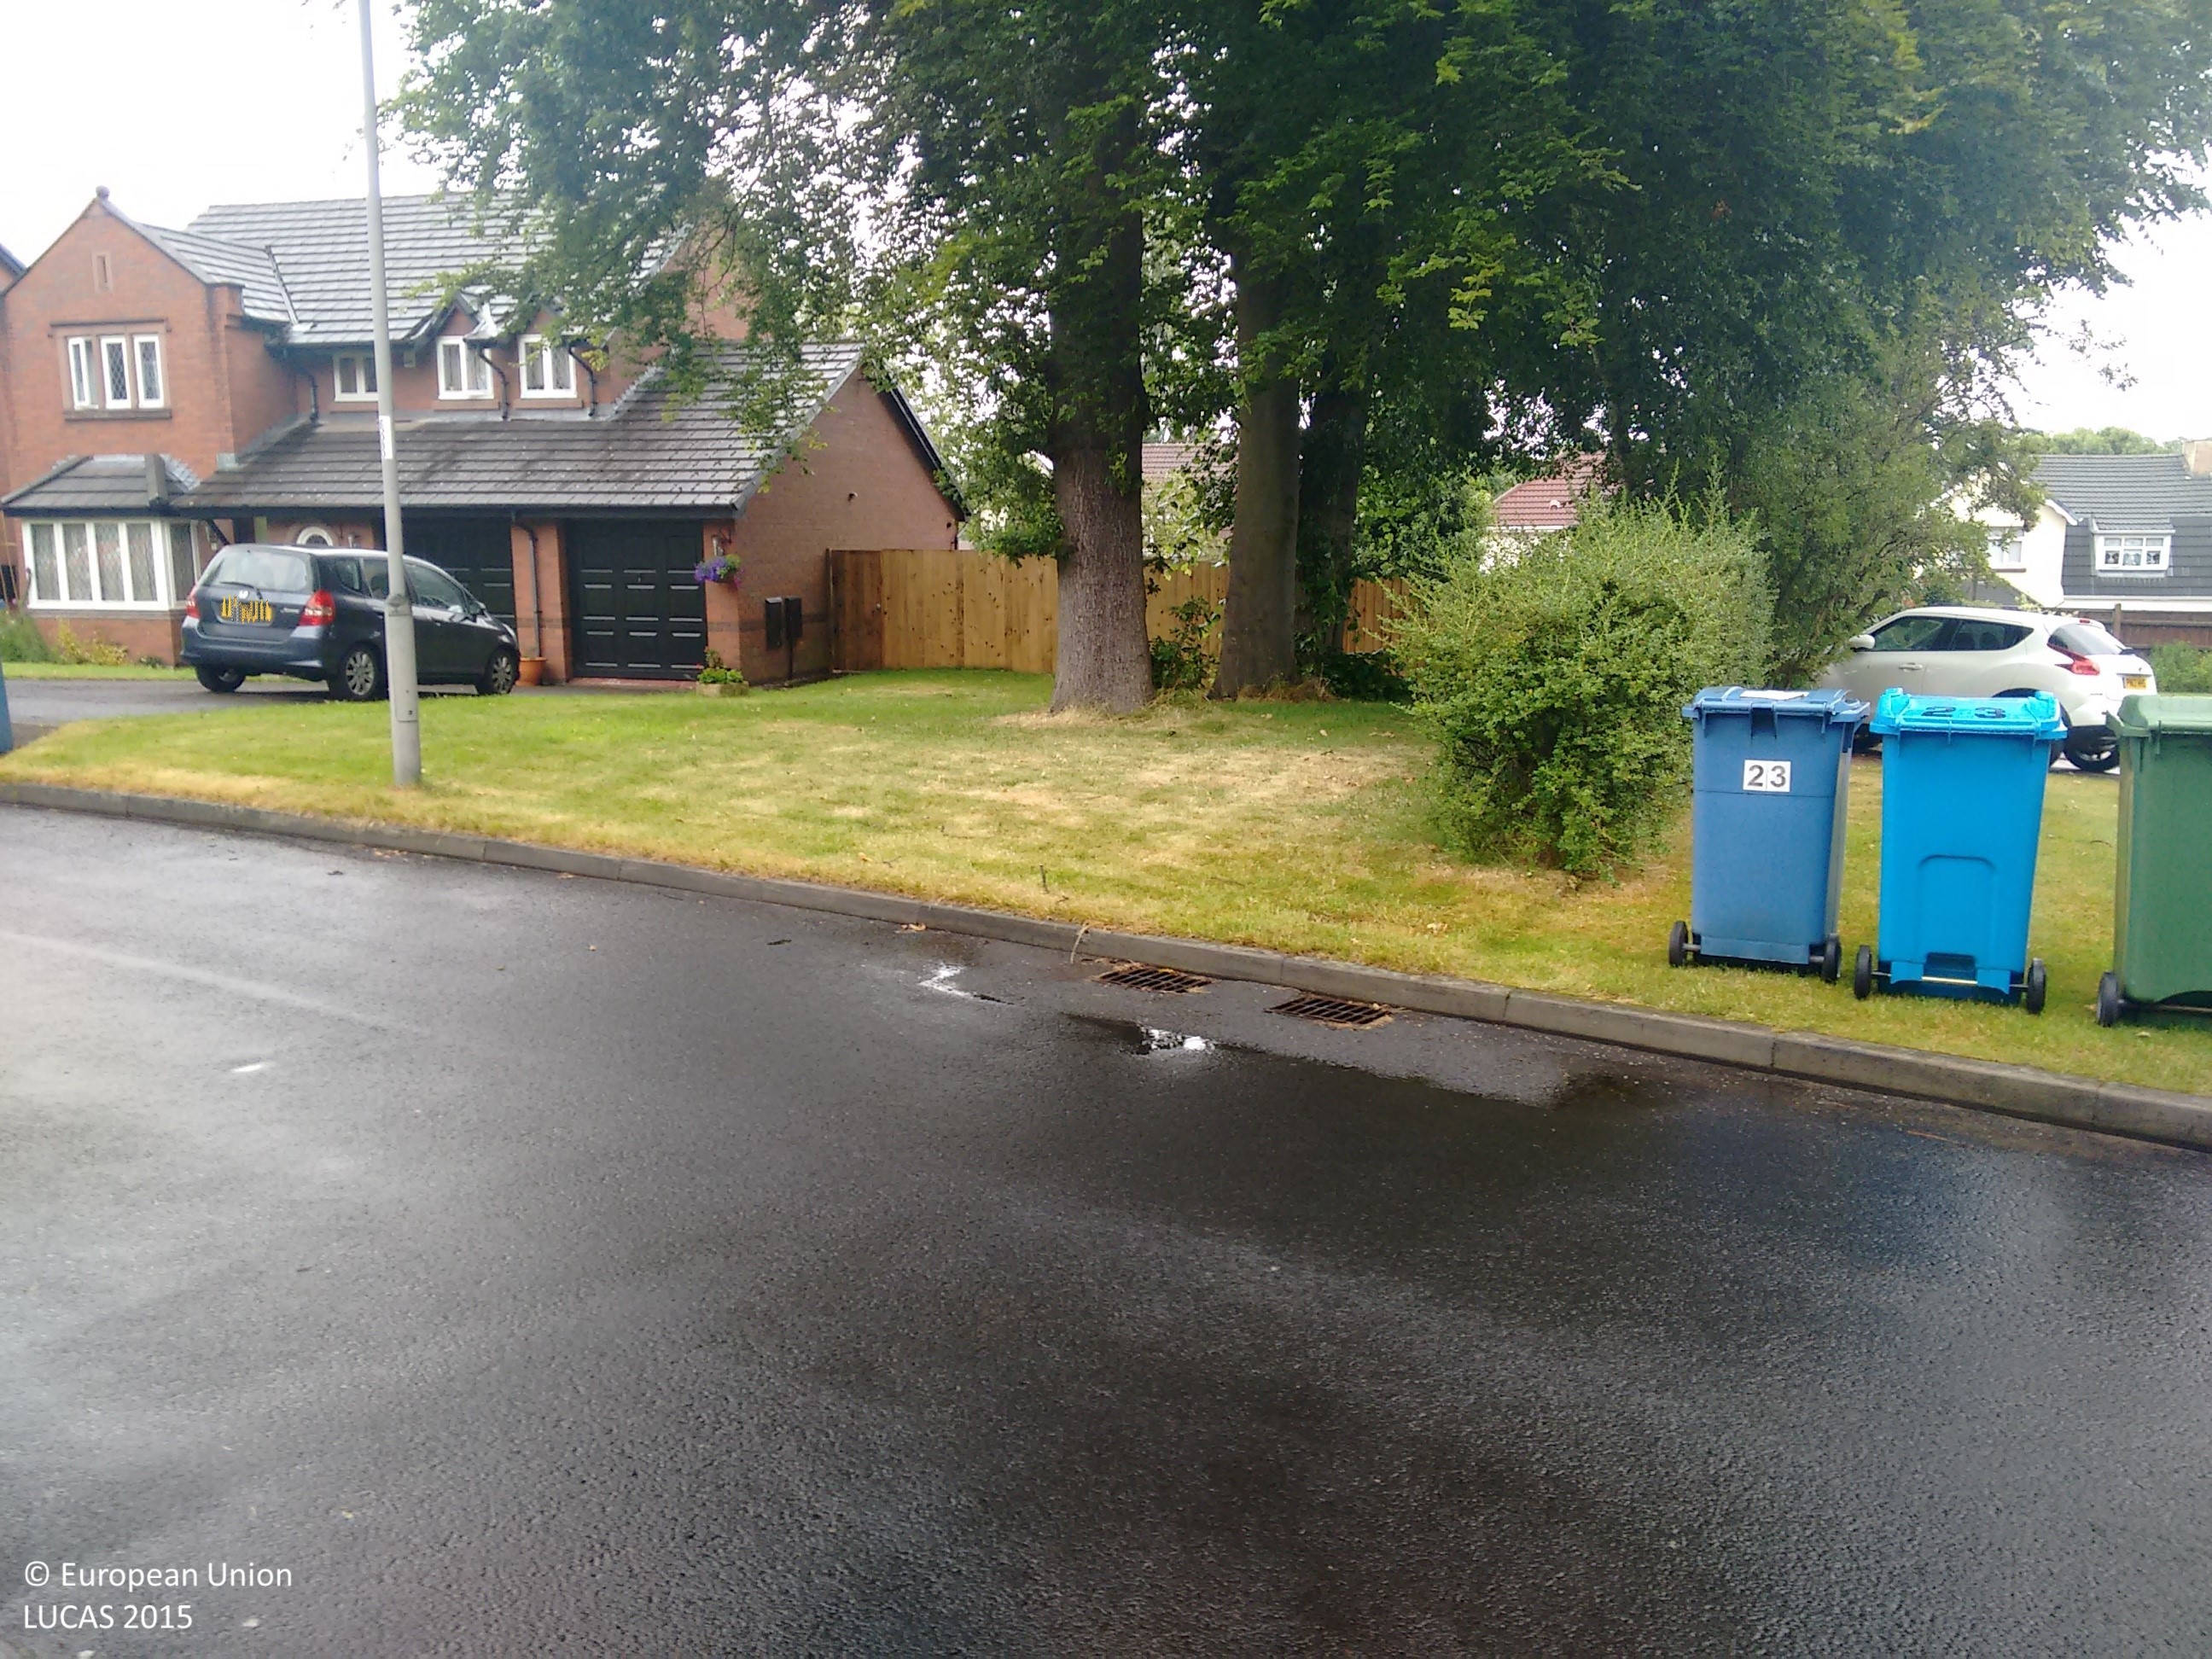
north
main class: Woodland
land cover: Broadleaved woodland
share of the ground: > 75 %
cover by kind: broadleaved forest trees 100 %
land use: Residential
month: July
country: GB
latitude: 53.3859
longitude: -2.8668
